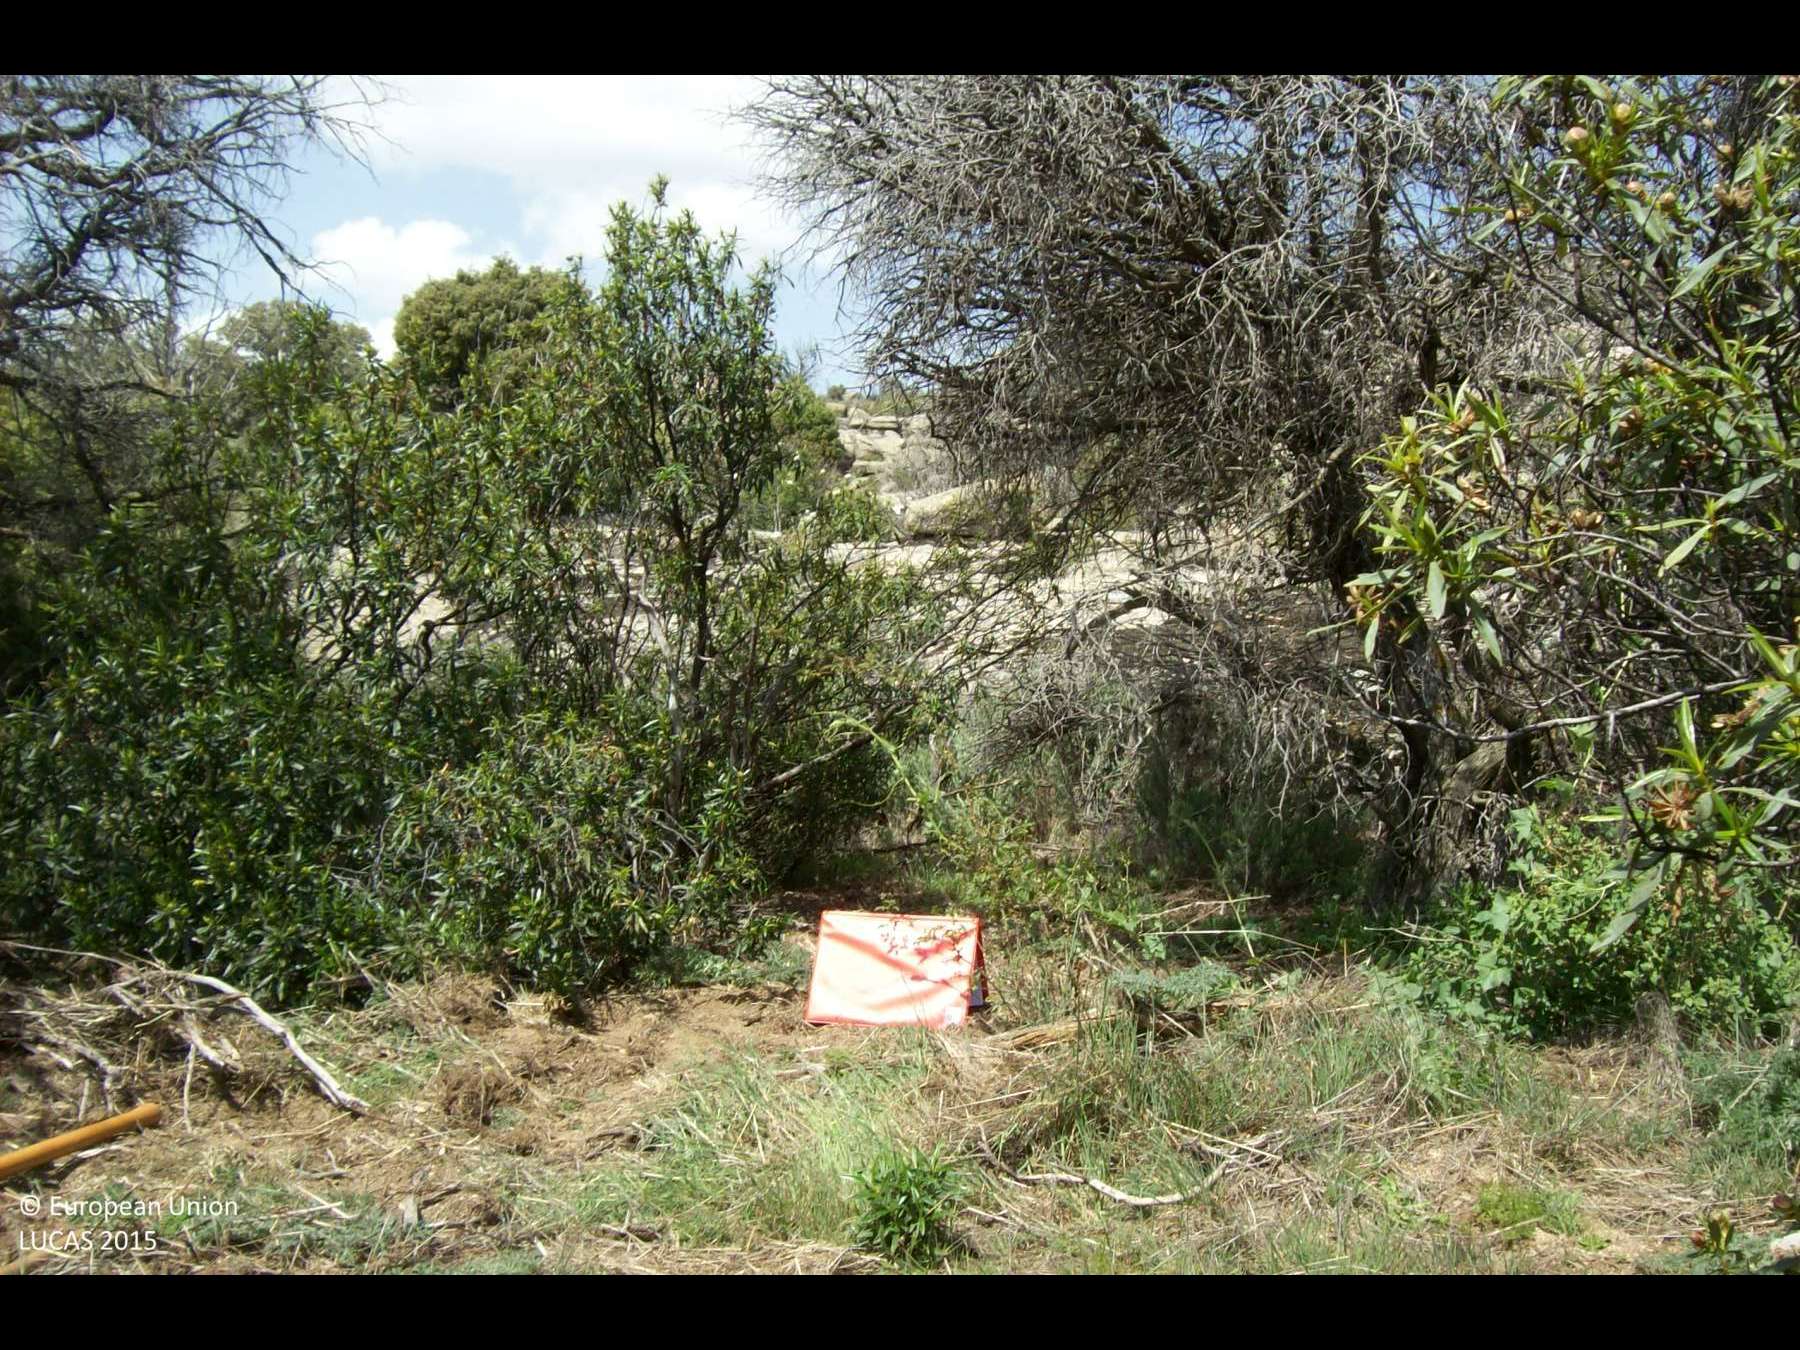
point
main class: Shrubland
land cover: Shrubland with sparse tree cover
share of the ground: > 75 %
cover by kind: consolidated bare surface 40 %, shrubs 35 %, herbaceous plants 20 %, coniferous forest trees 5 %
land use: Semi-natural and natural areas not in use
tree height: < 5 m
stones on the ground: < 10 %
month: April
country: ES
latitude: 40.6381
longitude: -3.9609
